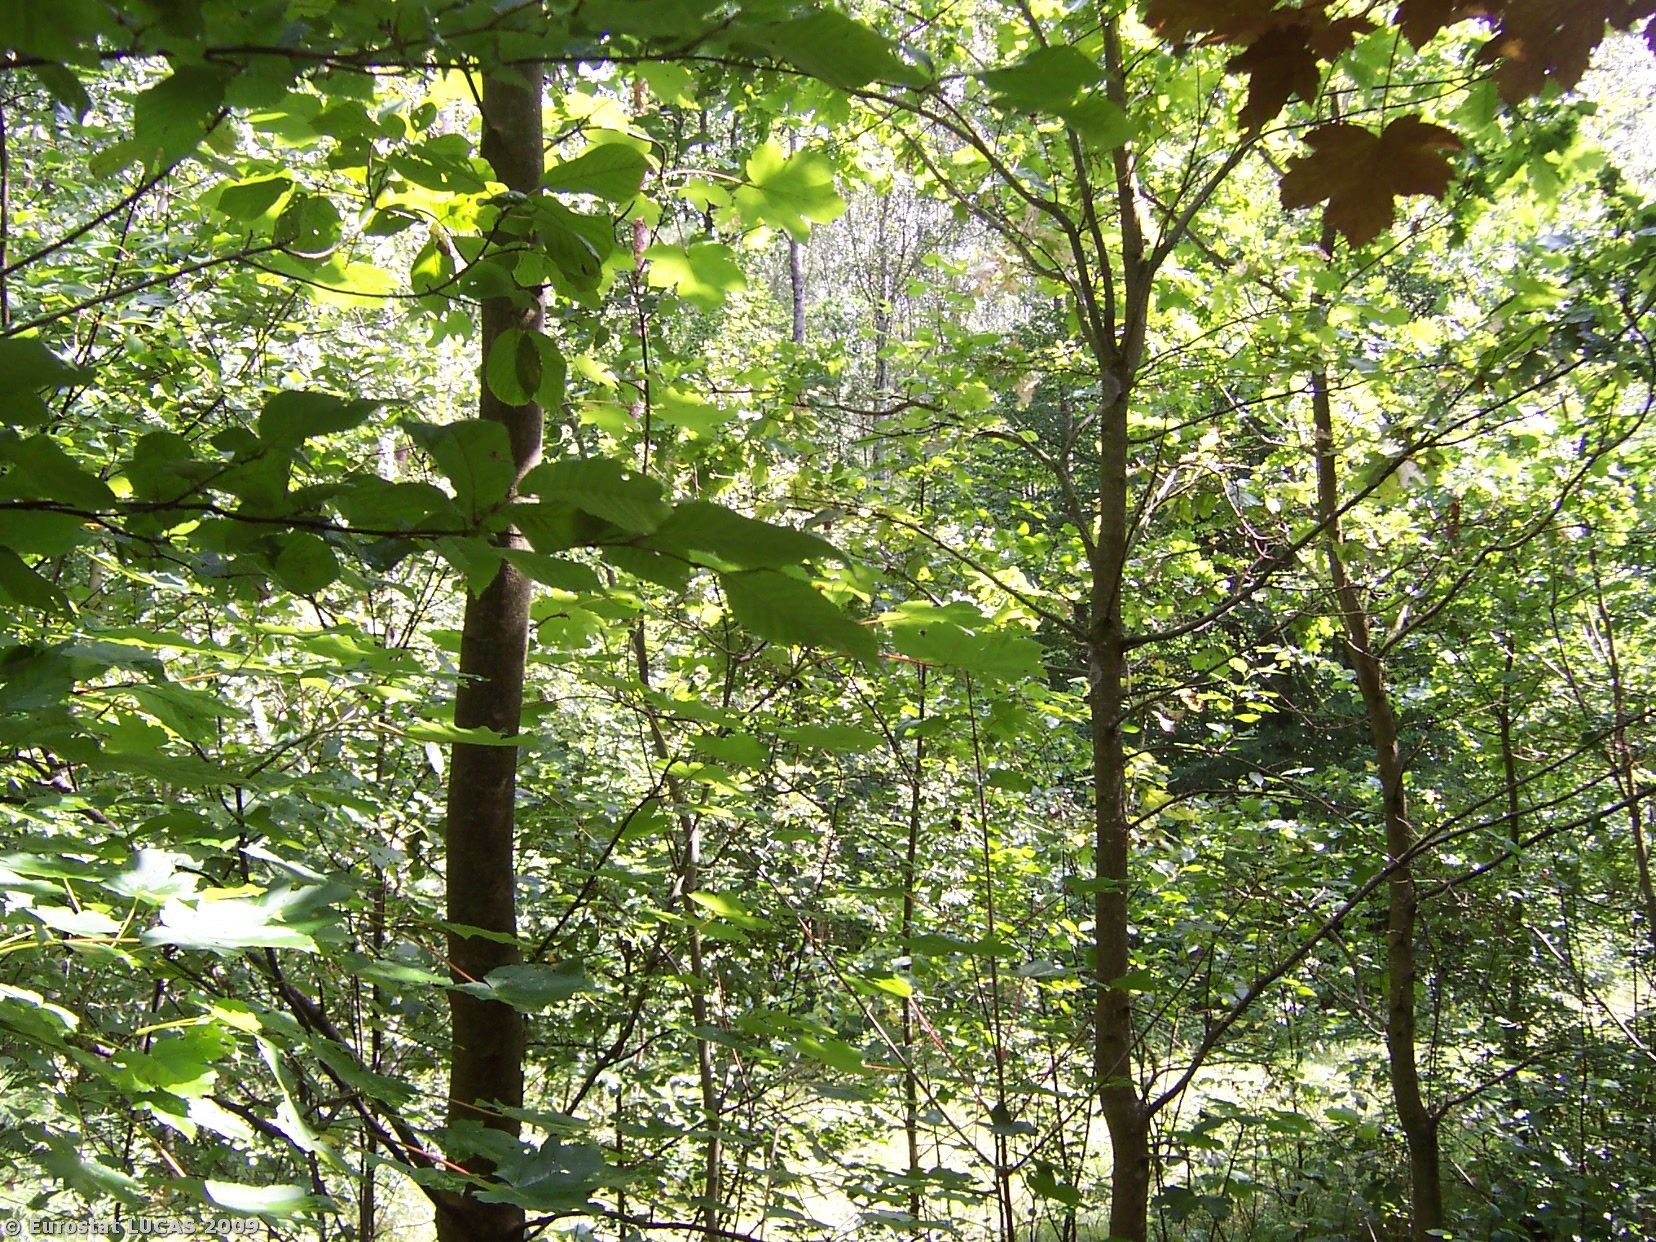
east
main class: Woodland
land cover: Broadleaved woodland
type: mesophytic deciduous forest
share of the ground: > 75 %
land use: Forestry
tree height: > 5 m
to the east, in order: Broadleaved woodland; Tracks; Broadleaved woodland
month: August
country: PL
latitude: 52.8118
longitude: 21.1583
